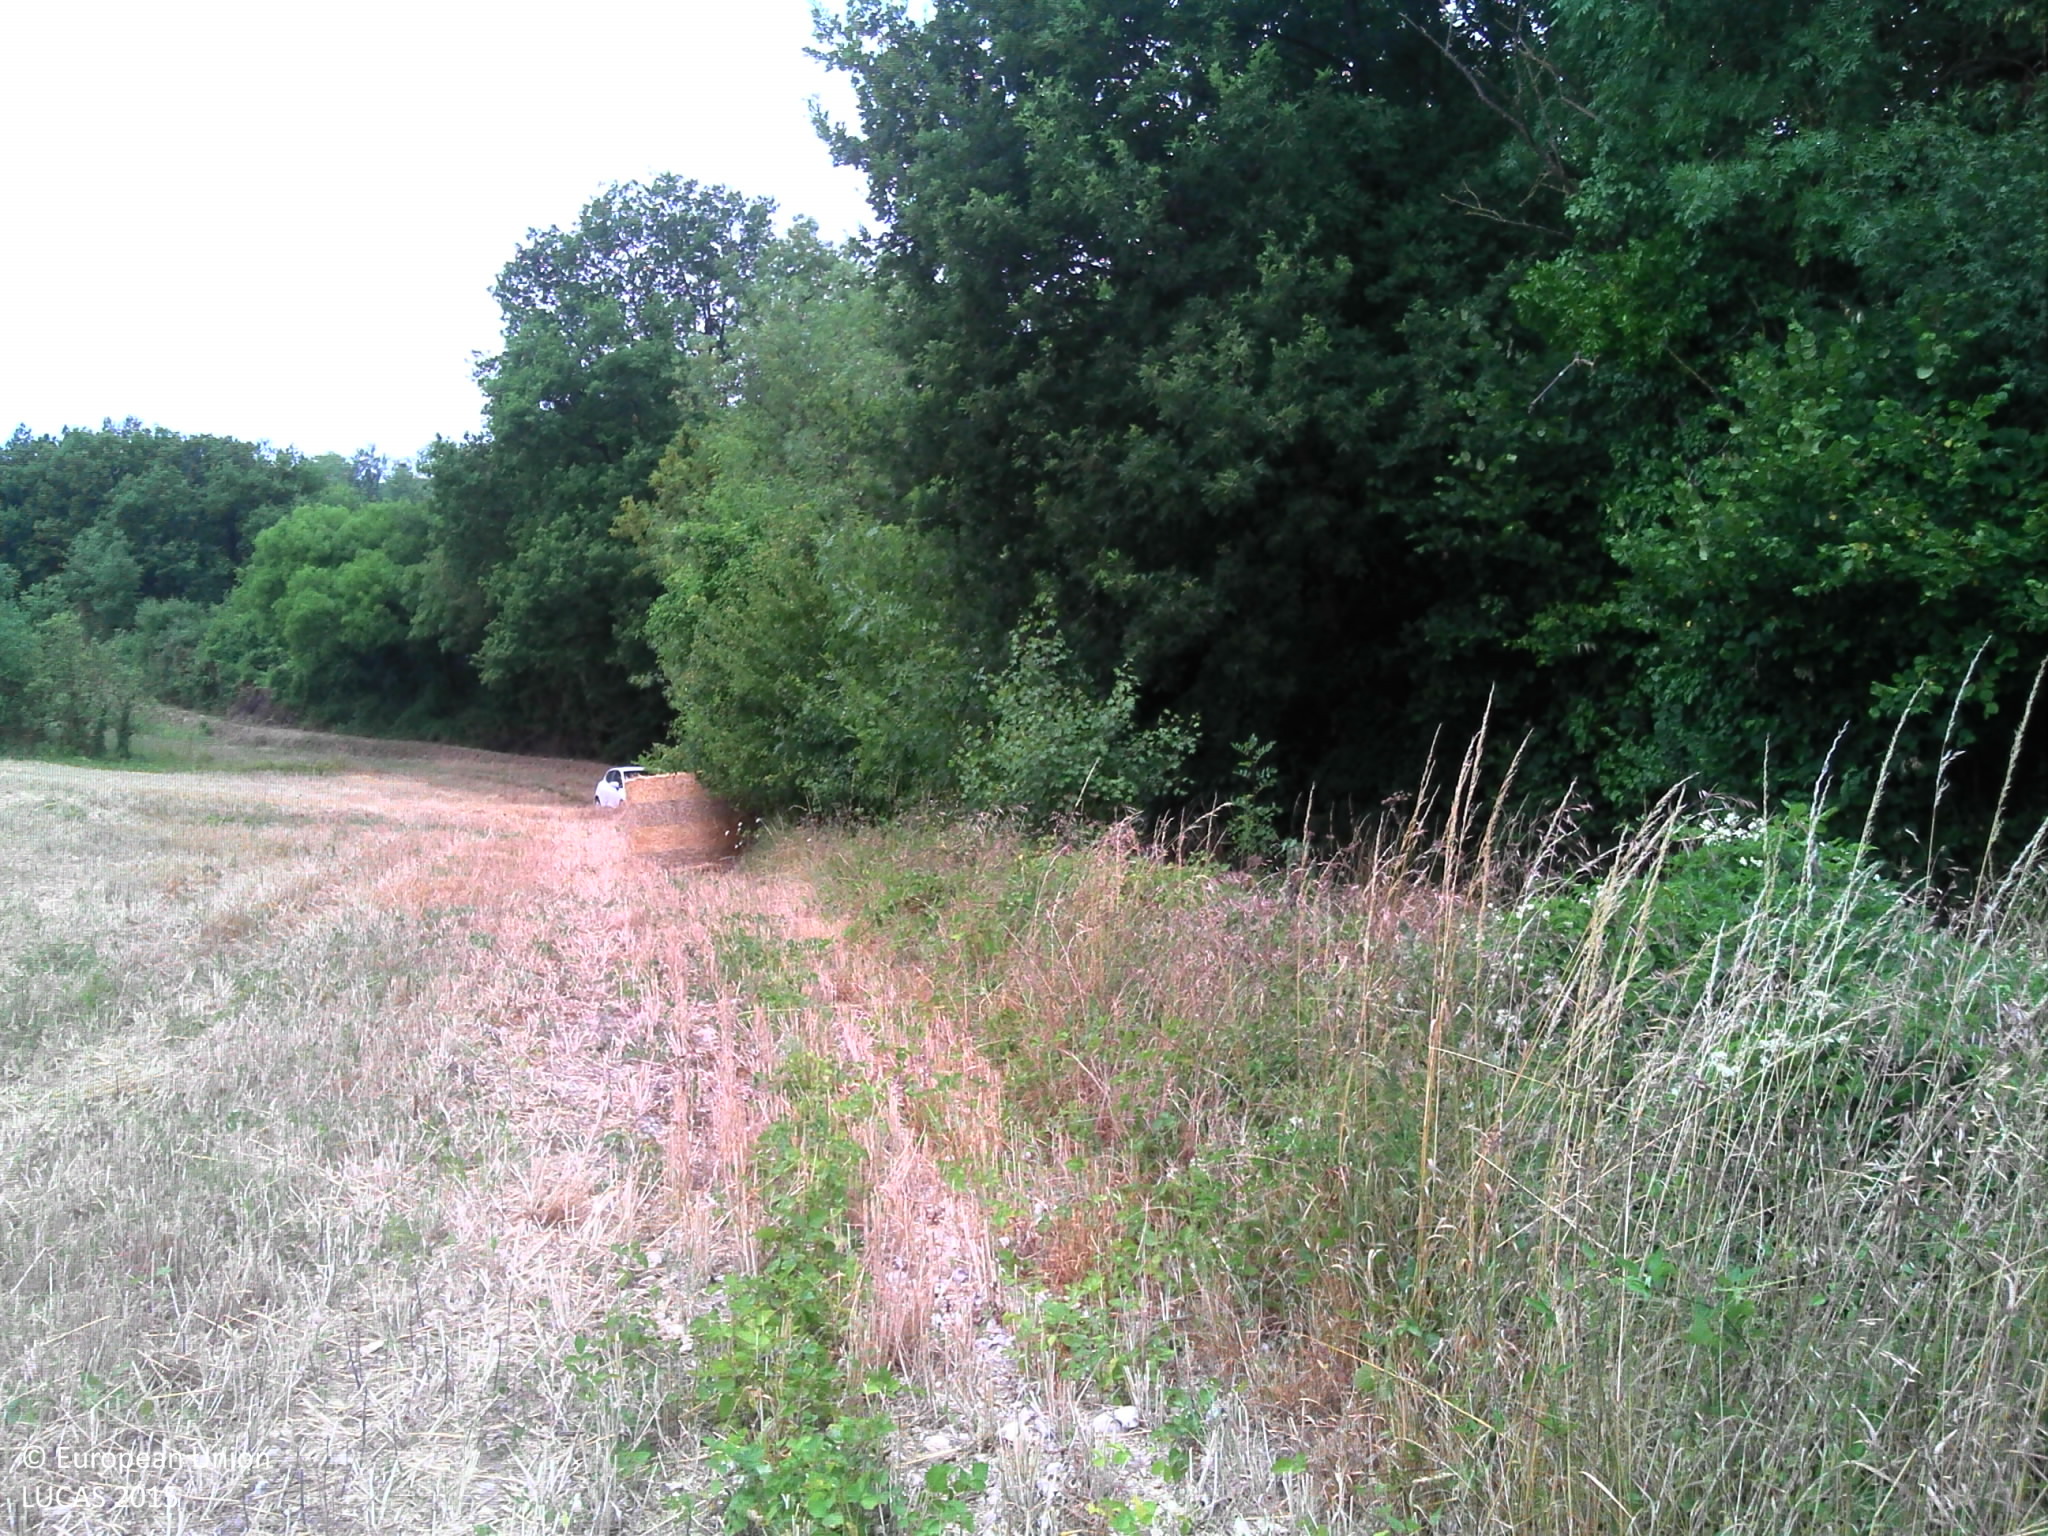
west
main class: Cropland
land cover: Common wheat
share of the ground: < 10 %
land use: Agriculture (excluding fallow land and kitchen gardens)
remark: Harvested field
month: July
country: FR
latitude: 47.3203
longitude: 0.4664
